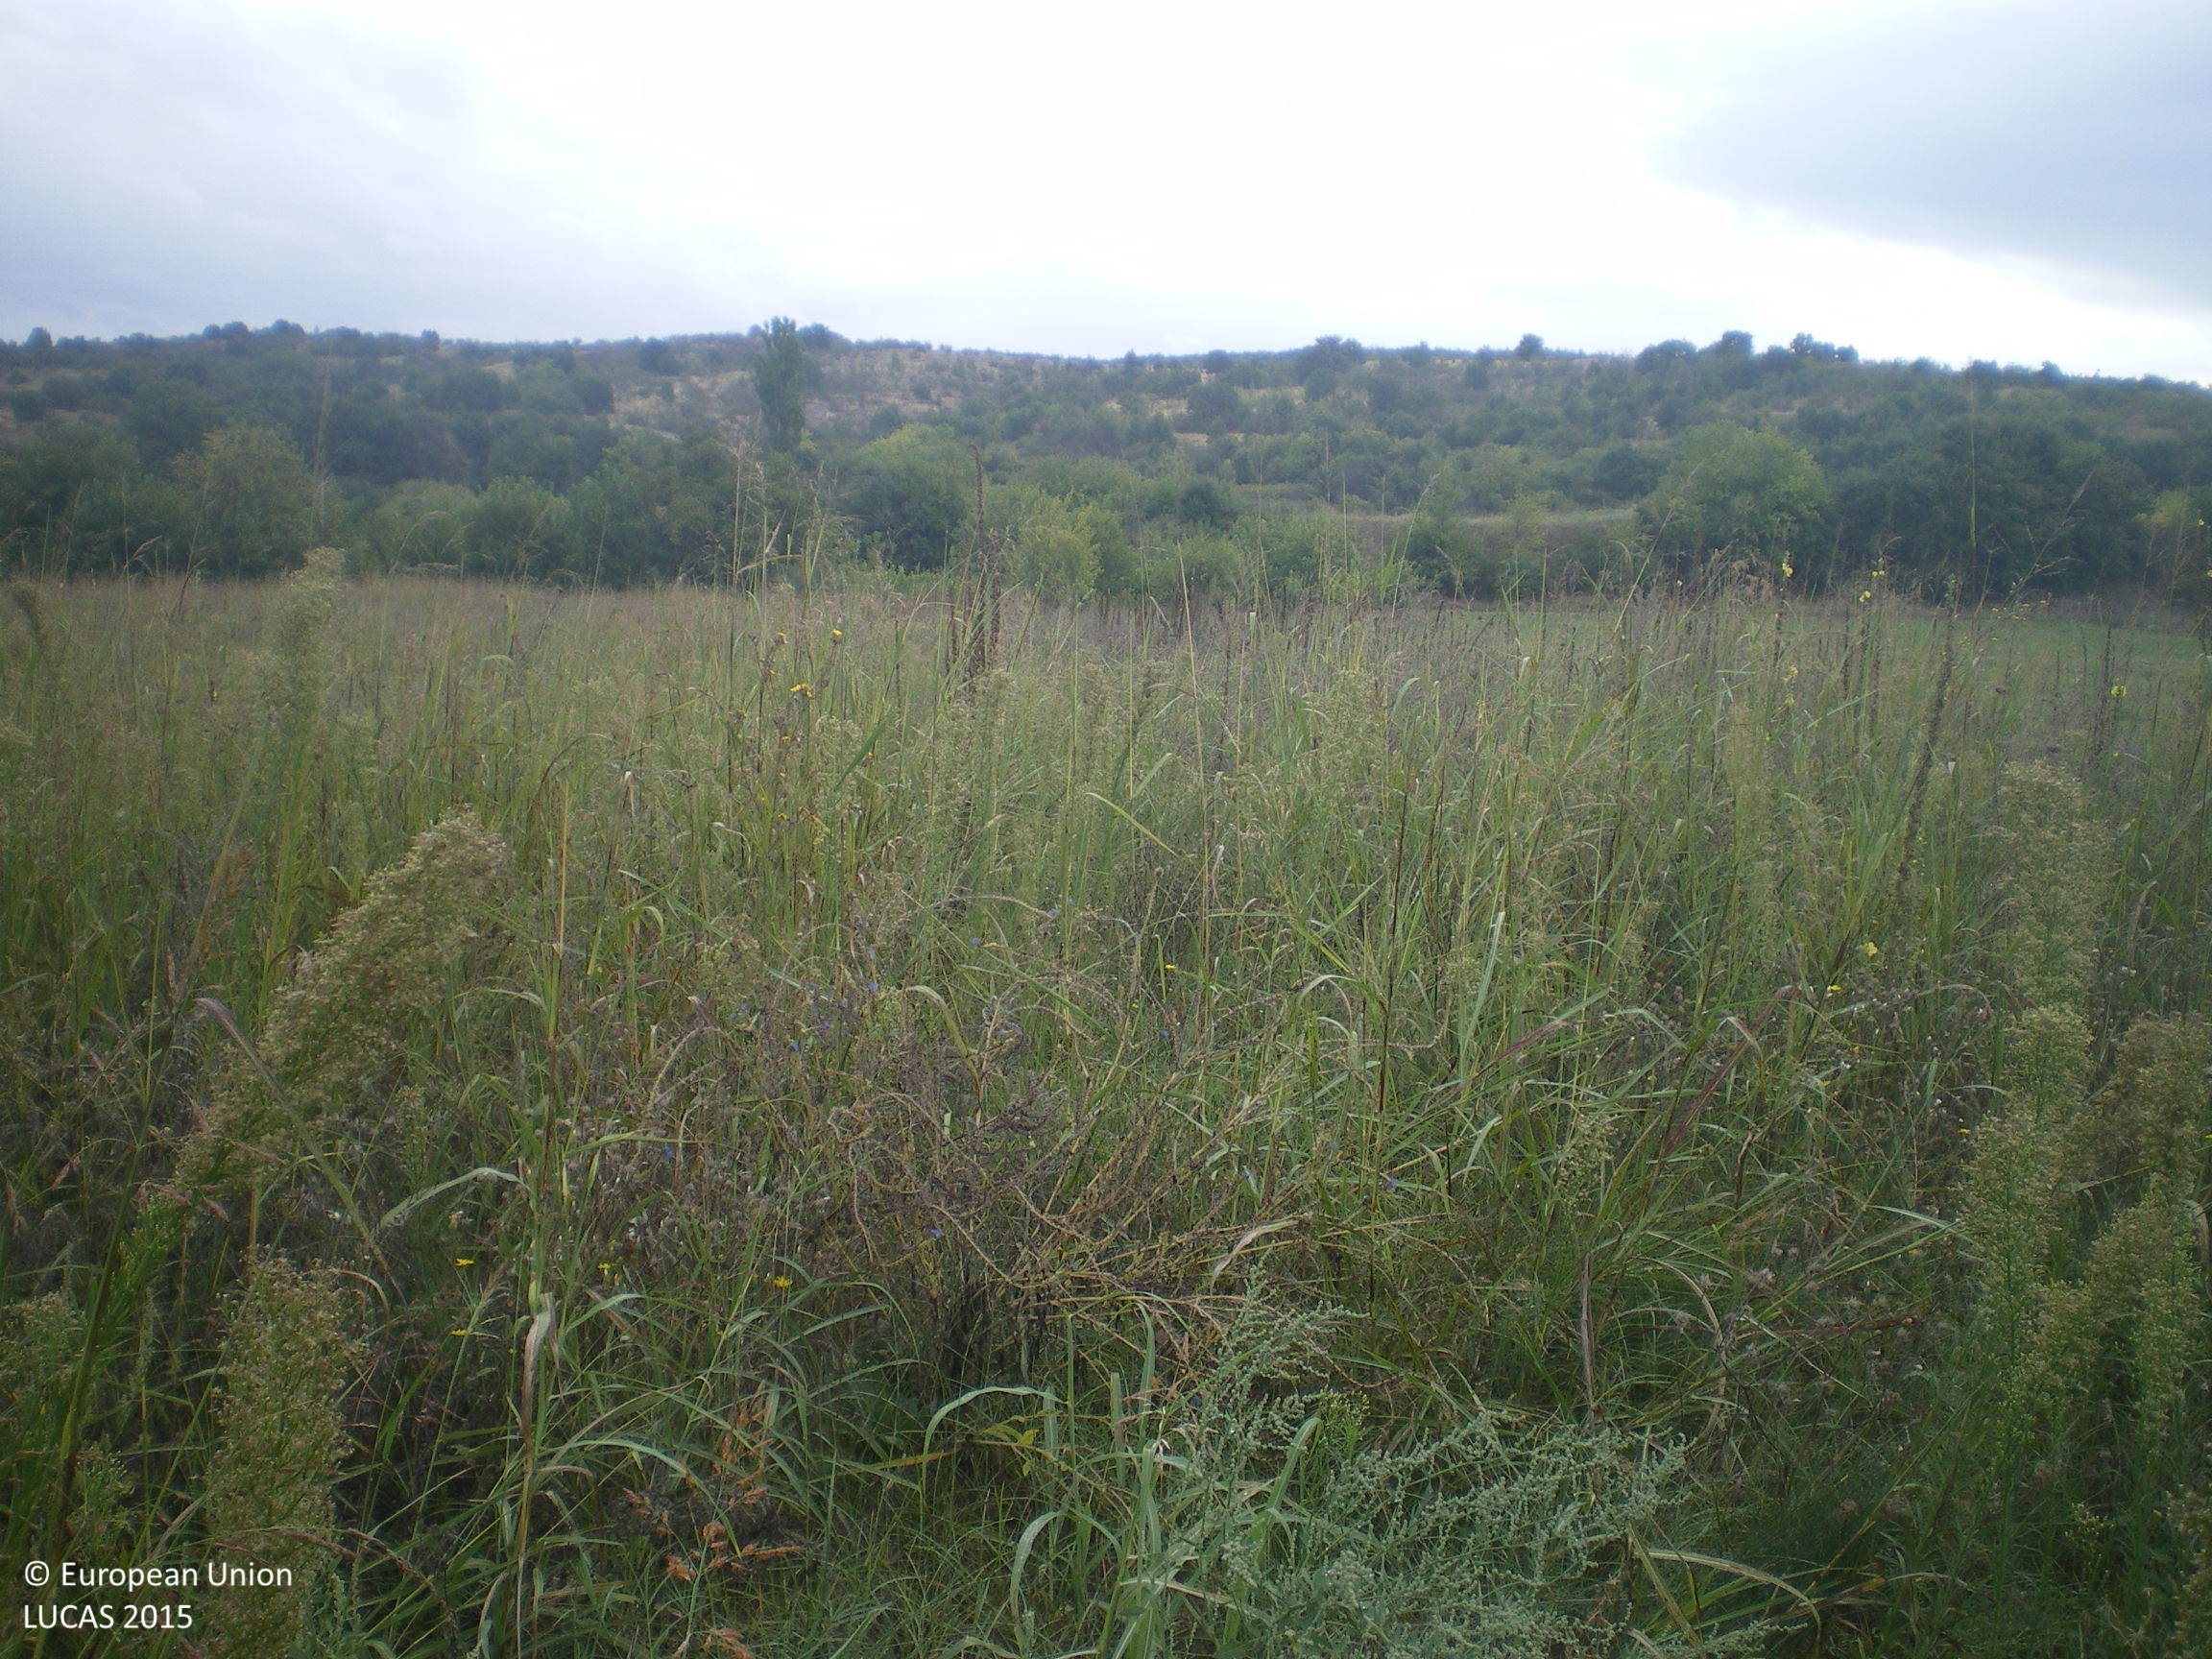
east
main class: Grassland
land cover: Spontaneously vegetated surfaces
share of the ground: > 75 %
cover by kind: herbaceous plants 100 %
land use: Fallow land
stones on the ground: < 10 %
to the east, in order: Spontaneously vegetated surfaces; Broadleaved woodland; Tobacco; Spontaneously vegetated surfaces; Broadleaved woodland; Grassland without tree/shrub cover; Grass margins; Tracks; Grass margins; Broadleaved woodland; Vineyards; Abandoned hedges; Grass margins; Paved roads, cycling and walking lanes; Grass margins; Ditches and canals; Shrubland without tree cover
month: September
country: BG
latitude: 41.9348
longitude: 25.9316
